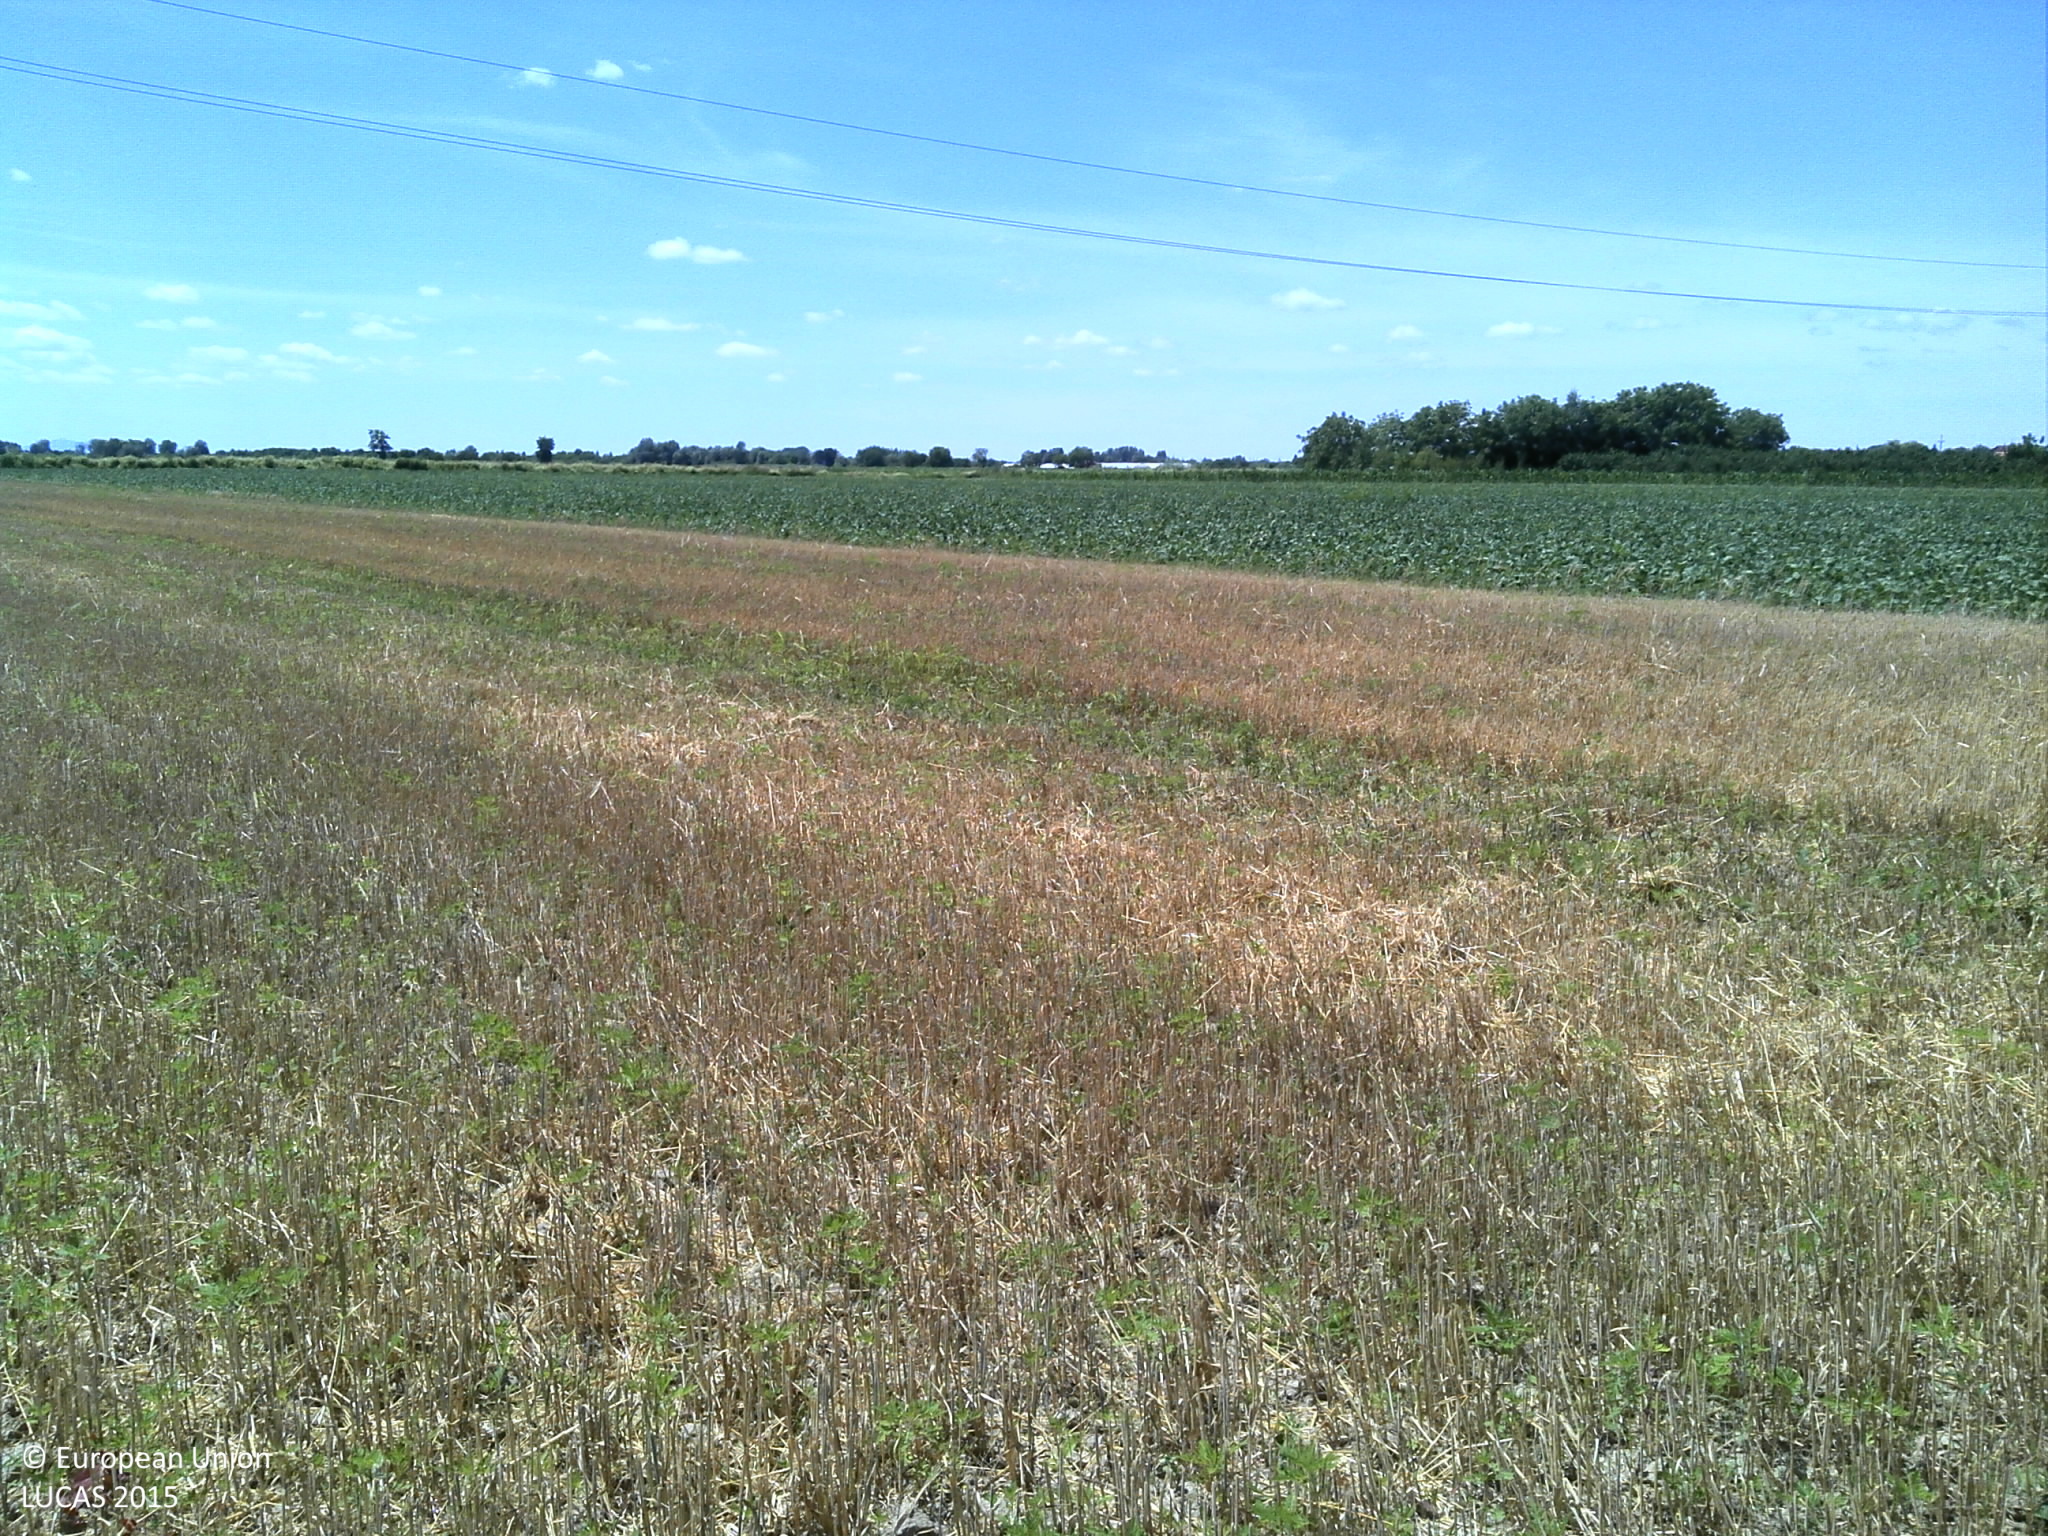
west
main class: Cropland
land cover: Barley
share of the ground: < 10 %
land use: Agriculture (excluding fallow land and kitchen gardens)
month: June
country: HR
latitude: 45.7488
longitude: 18.1681
